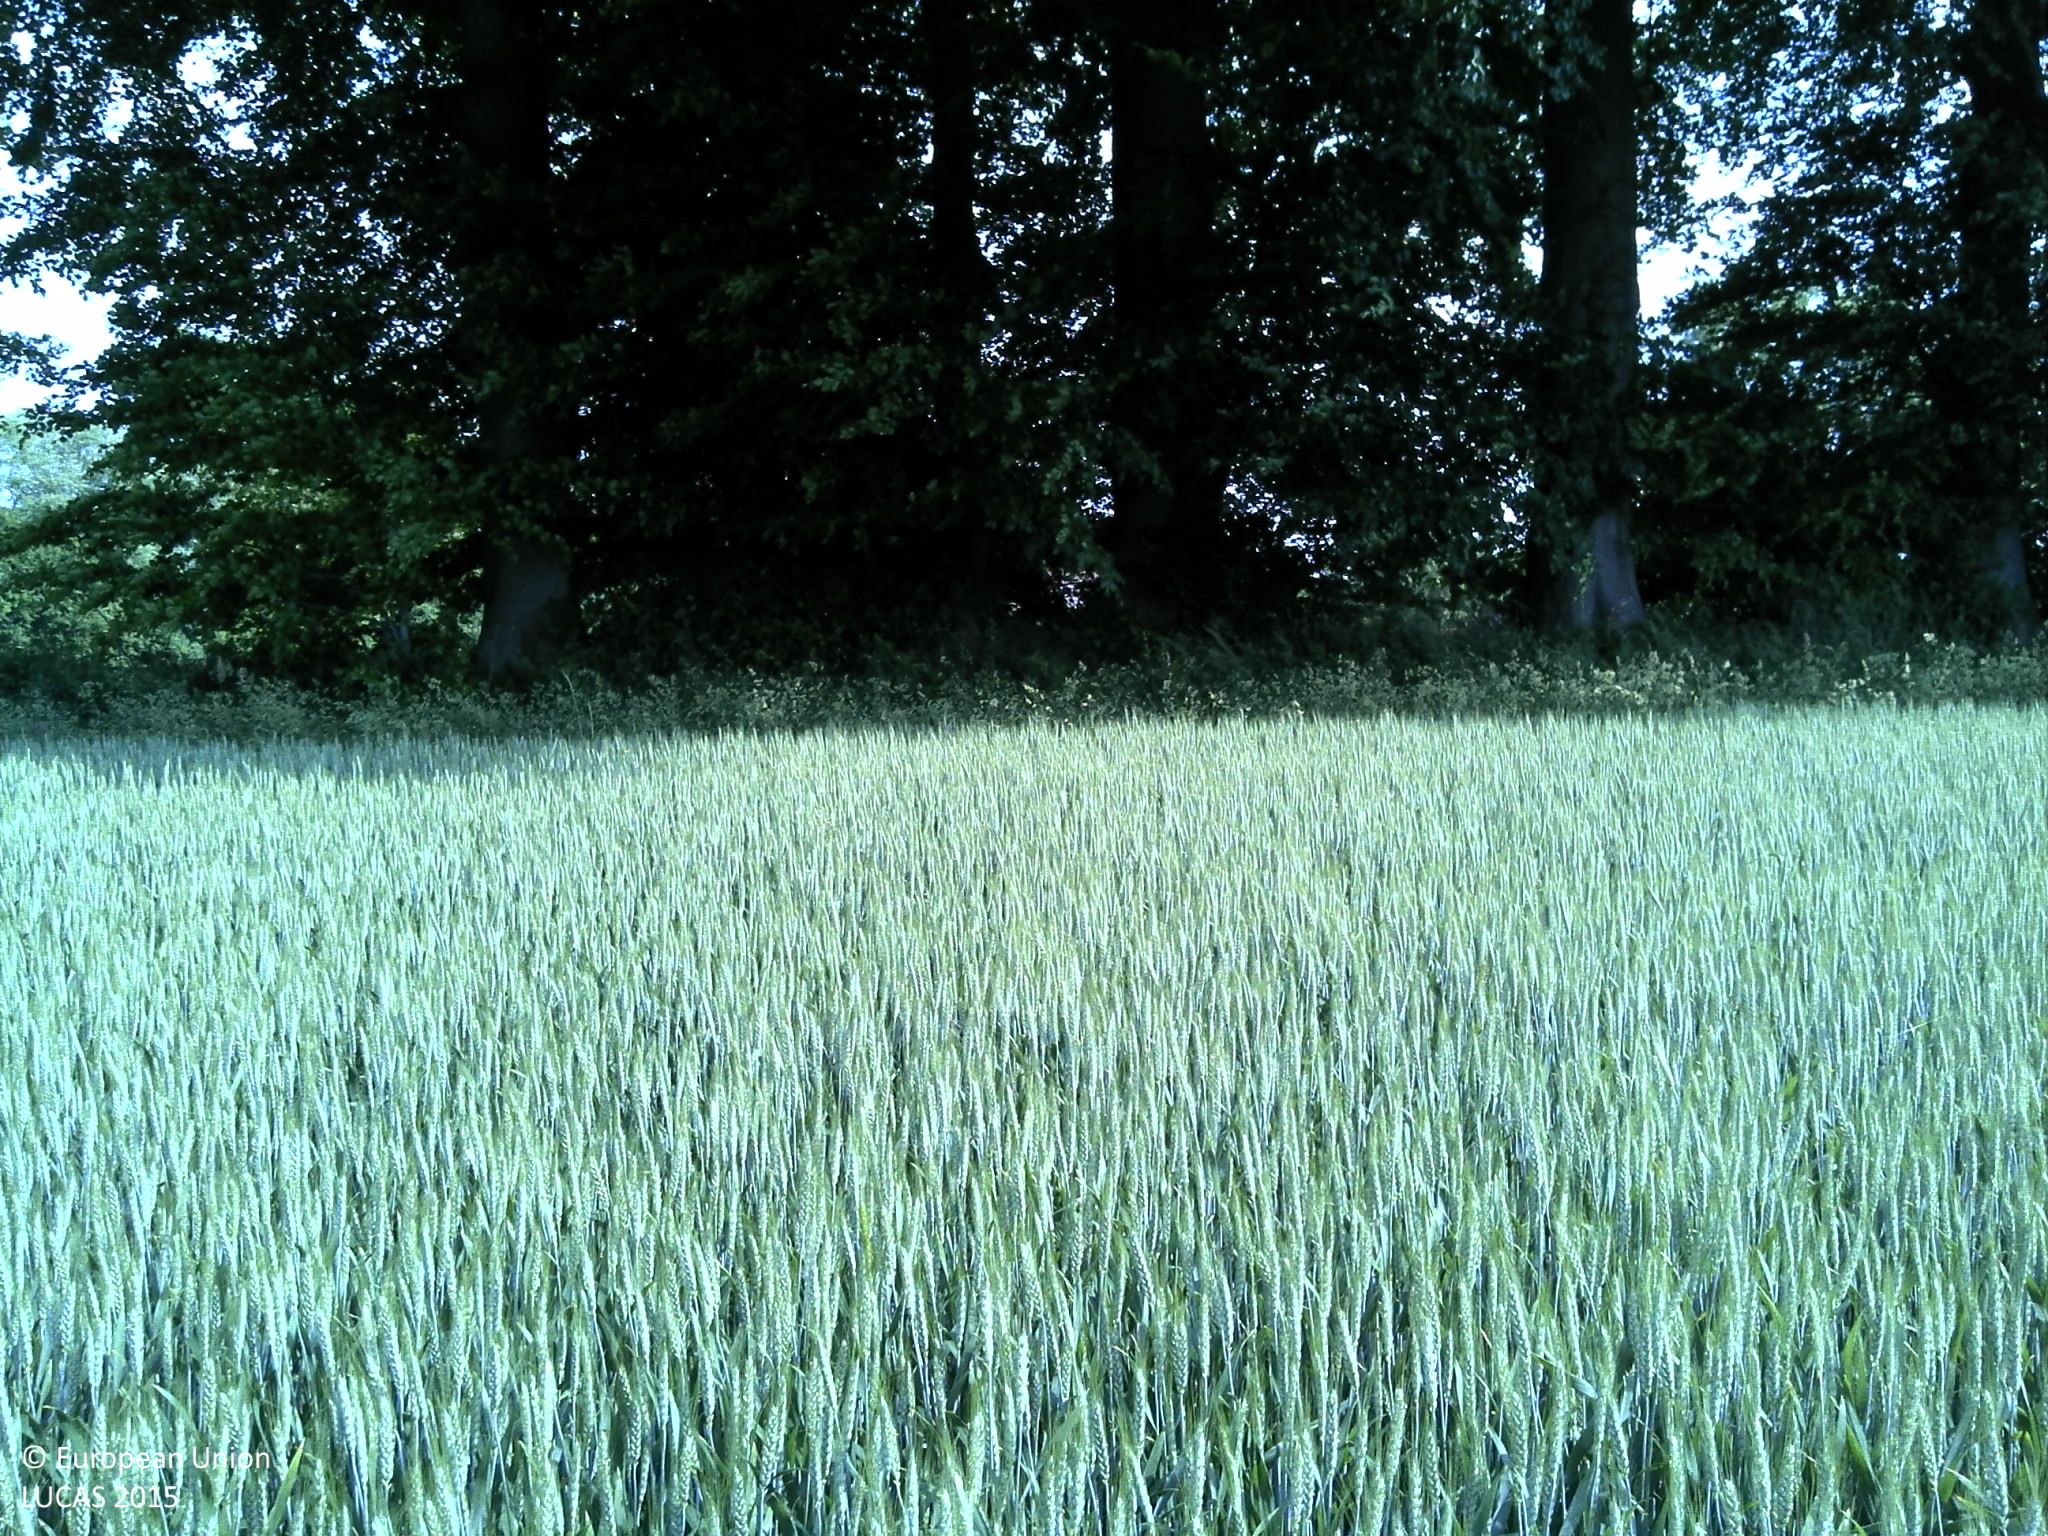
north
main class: Cropland
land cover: Common wheat
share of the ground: > 75 %
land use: Agriculture (excluding fallow land and kitchen gardens)
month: June
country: FR
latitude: 49.7482
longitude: 1.1379
